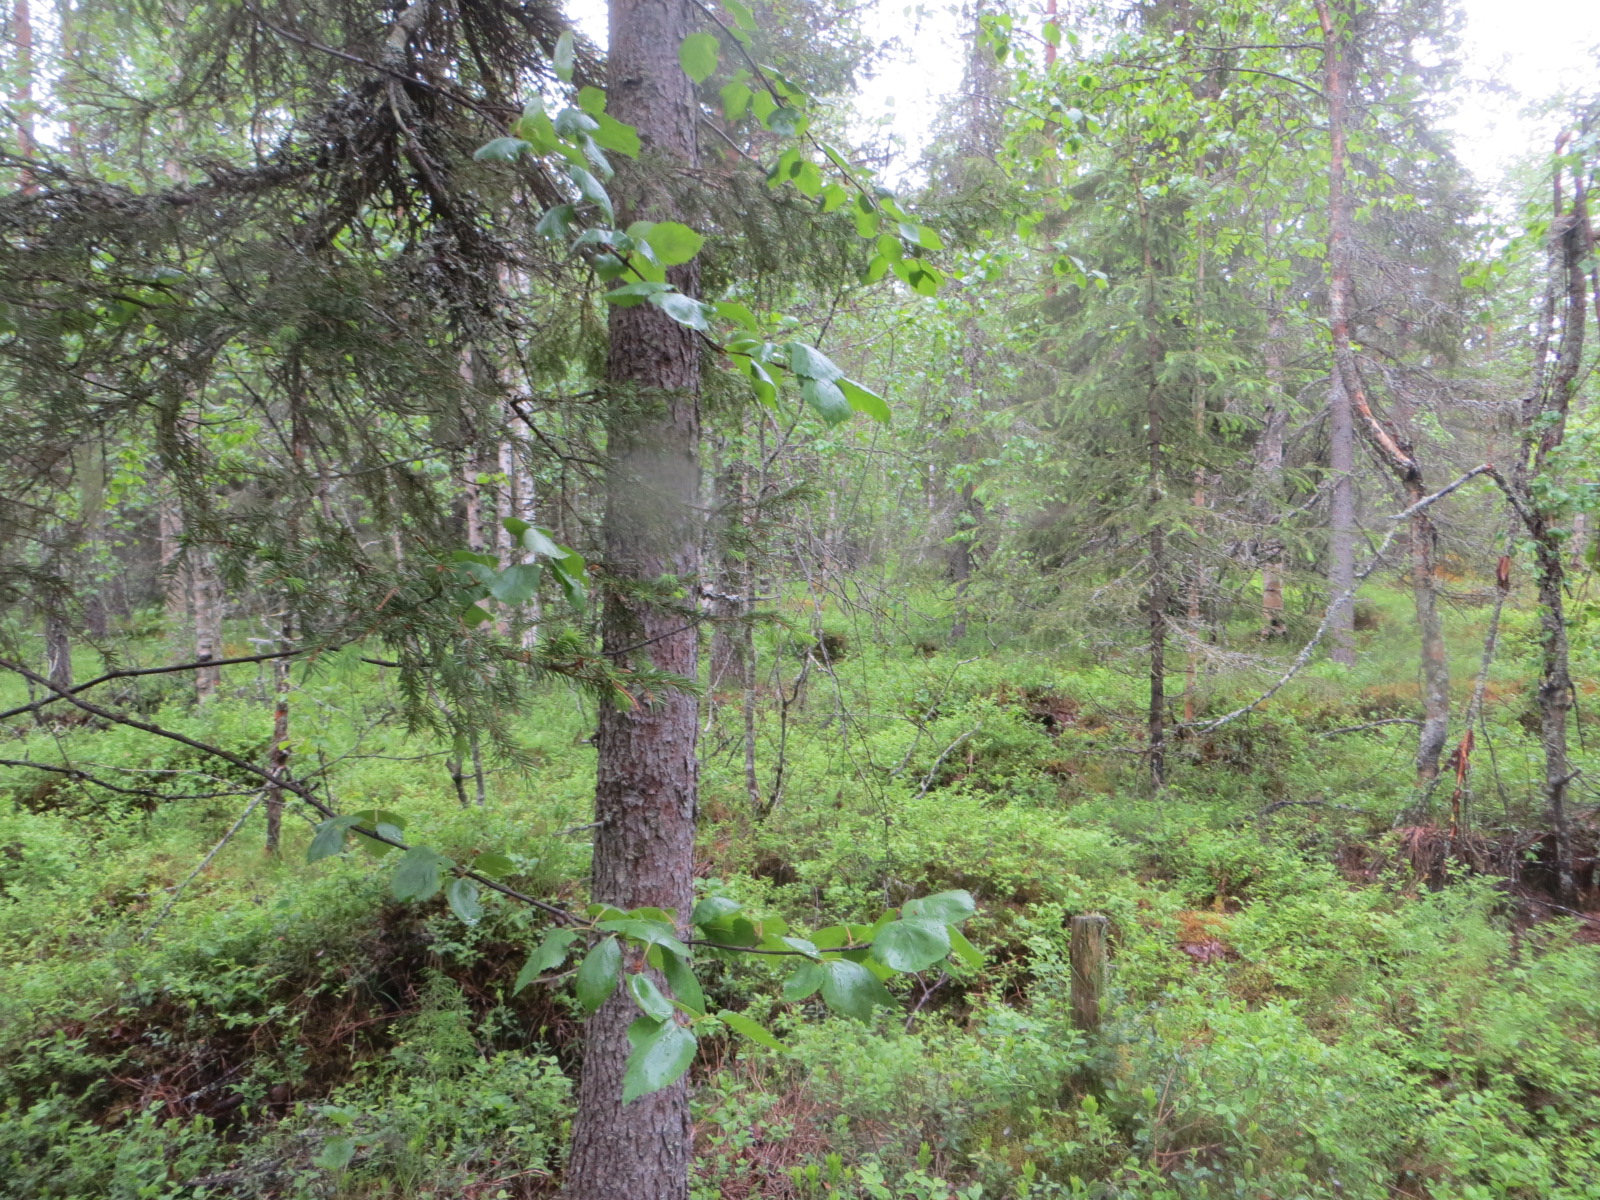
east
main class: Woodland
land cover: Other mixed woodland
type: boreal forest
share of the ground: > 75 %
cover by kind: coniferous forest trees 40 %, broadleaved forest trees 35 %, shrubs 25 %
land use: Forestry
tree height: > 5 m
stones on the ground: < 10 %
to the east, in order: Other mixed woodland; Ditches and canals; Other mixed woodland; Ditches and canals; Spruce dominated mixed woodland; Inland fresh water bodies; Broadleaved woodland; Grassland without tree/shrub cover; Broadleaved woodland
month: June
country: FI
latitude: 66.0597
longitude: 26.9563
